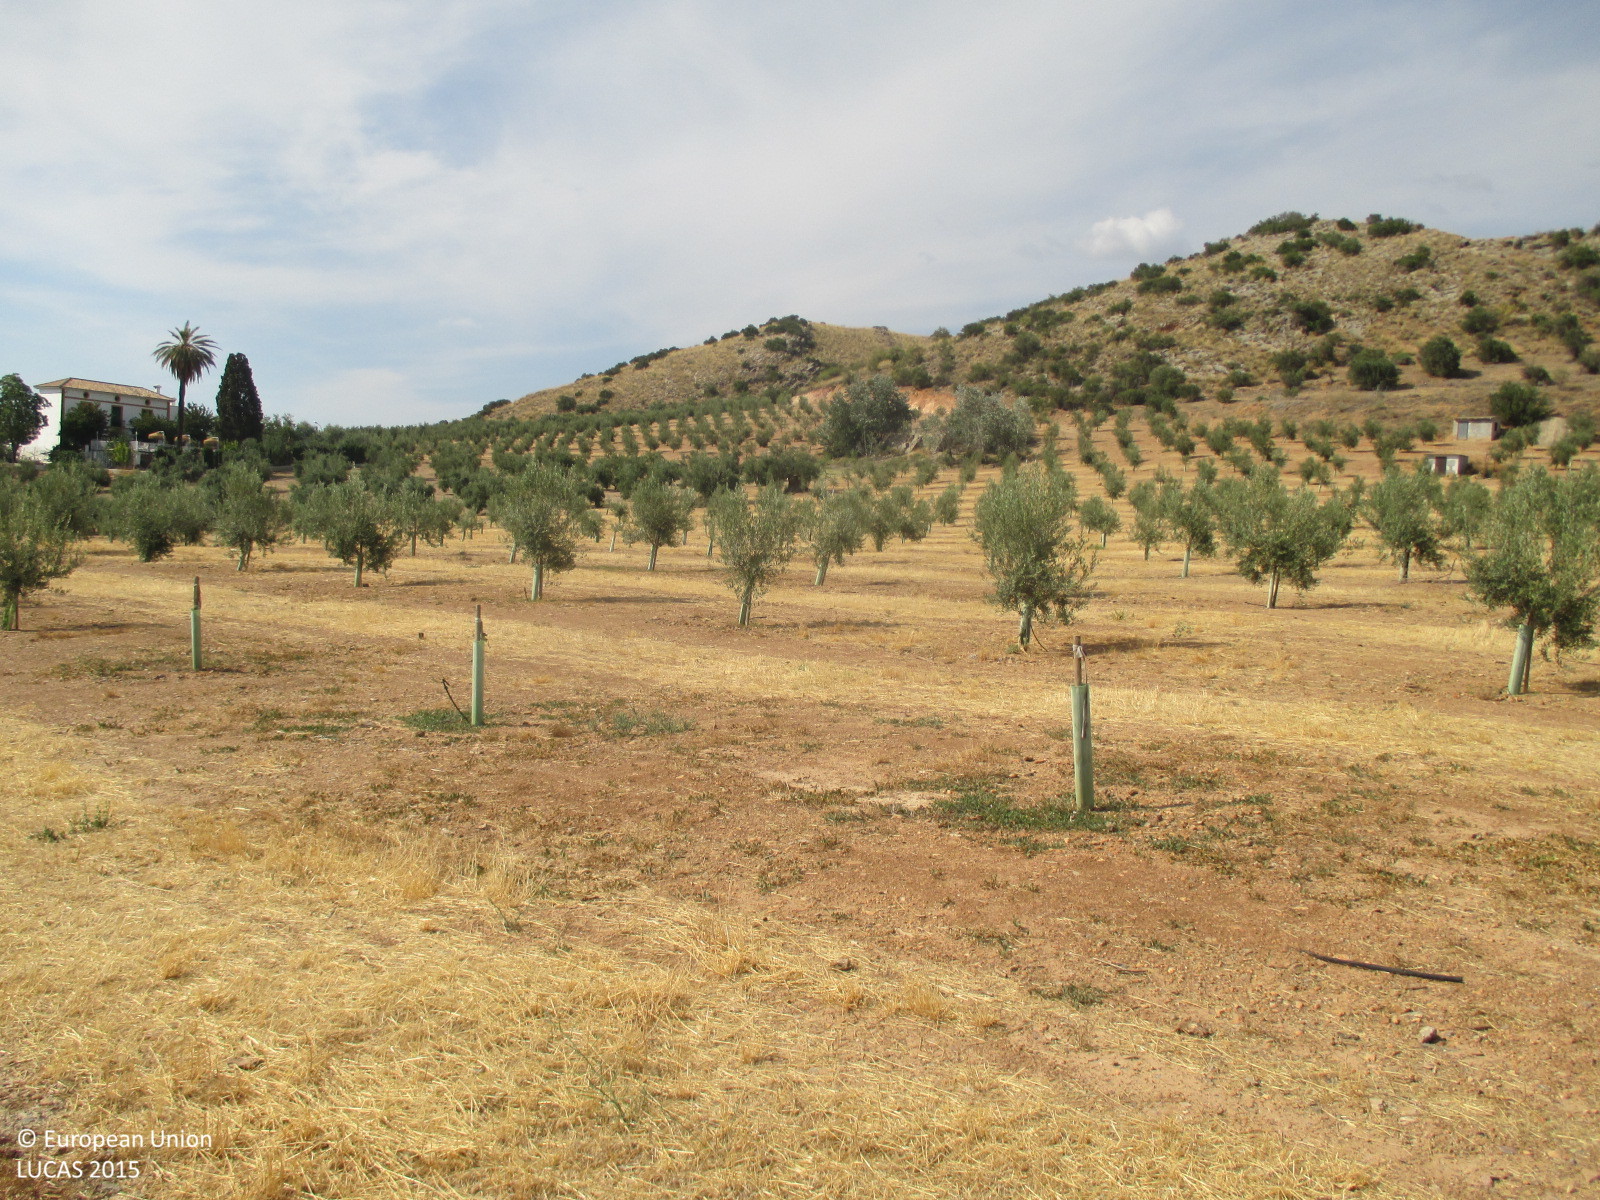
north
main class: Cropland
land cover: Olive groves
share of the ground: < 10 %
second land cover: Spontaneously vegetated surfaces
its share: 10 - 25 %
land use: Agriculture (excluding fallow land and kitchen gardens)
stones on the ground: < 10 %
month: June
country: ES
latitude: 37.5881
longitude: -4.1234
